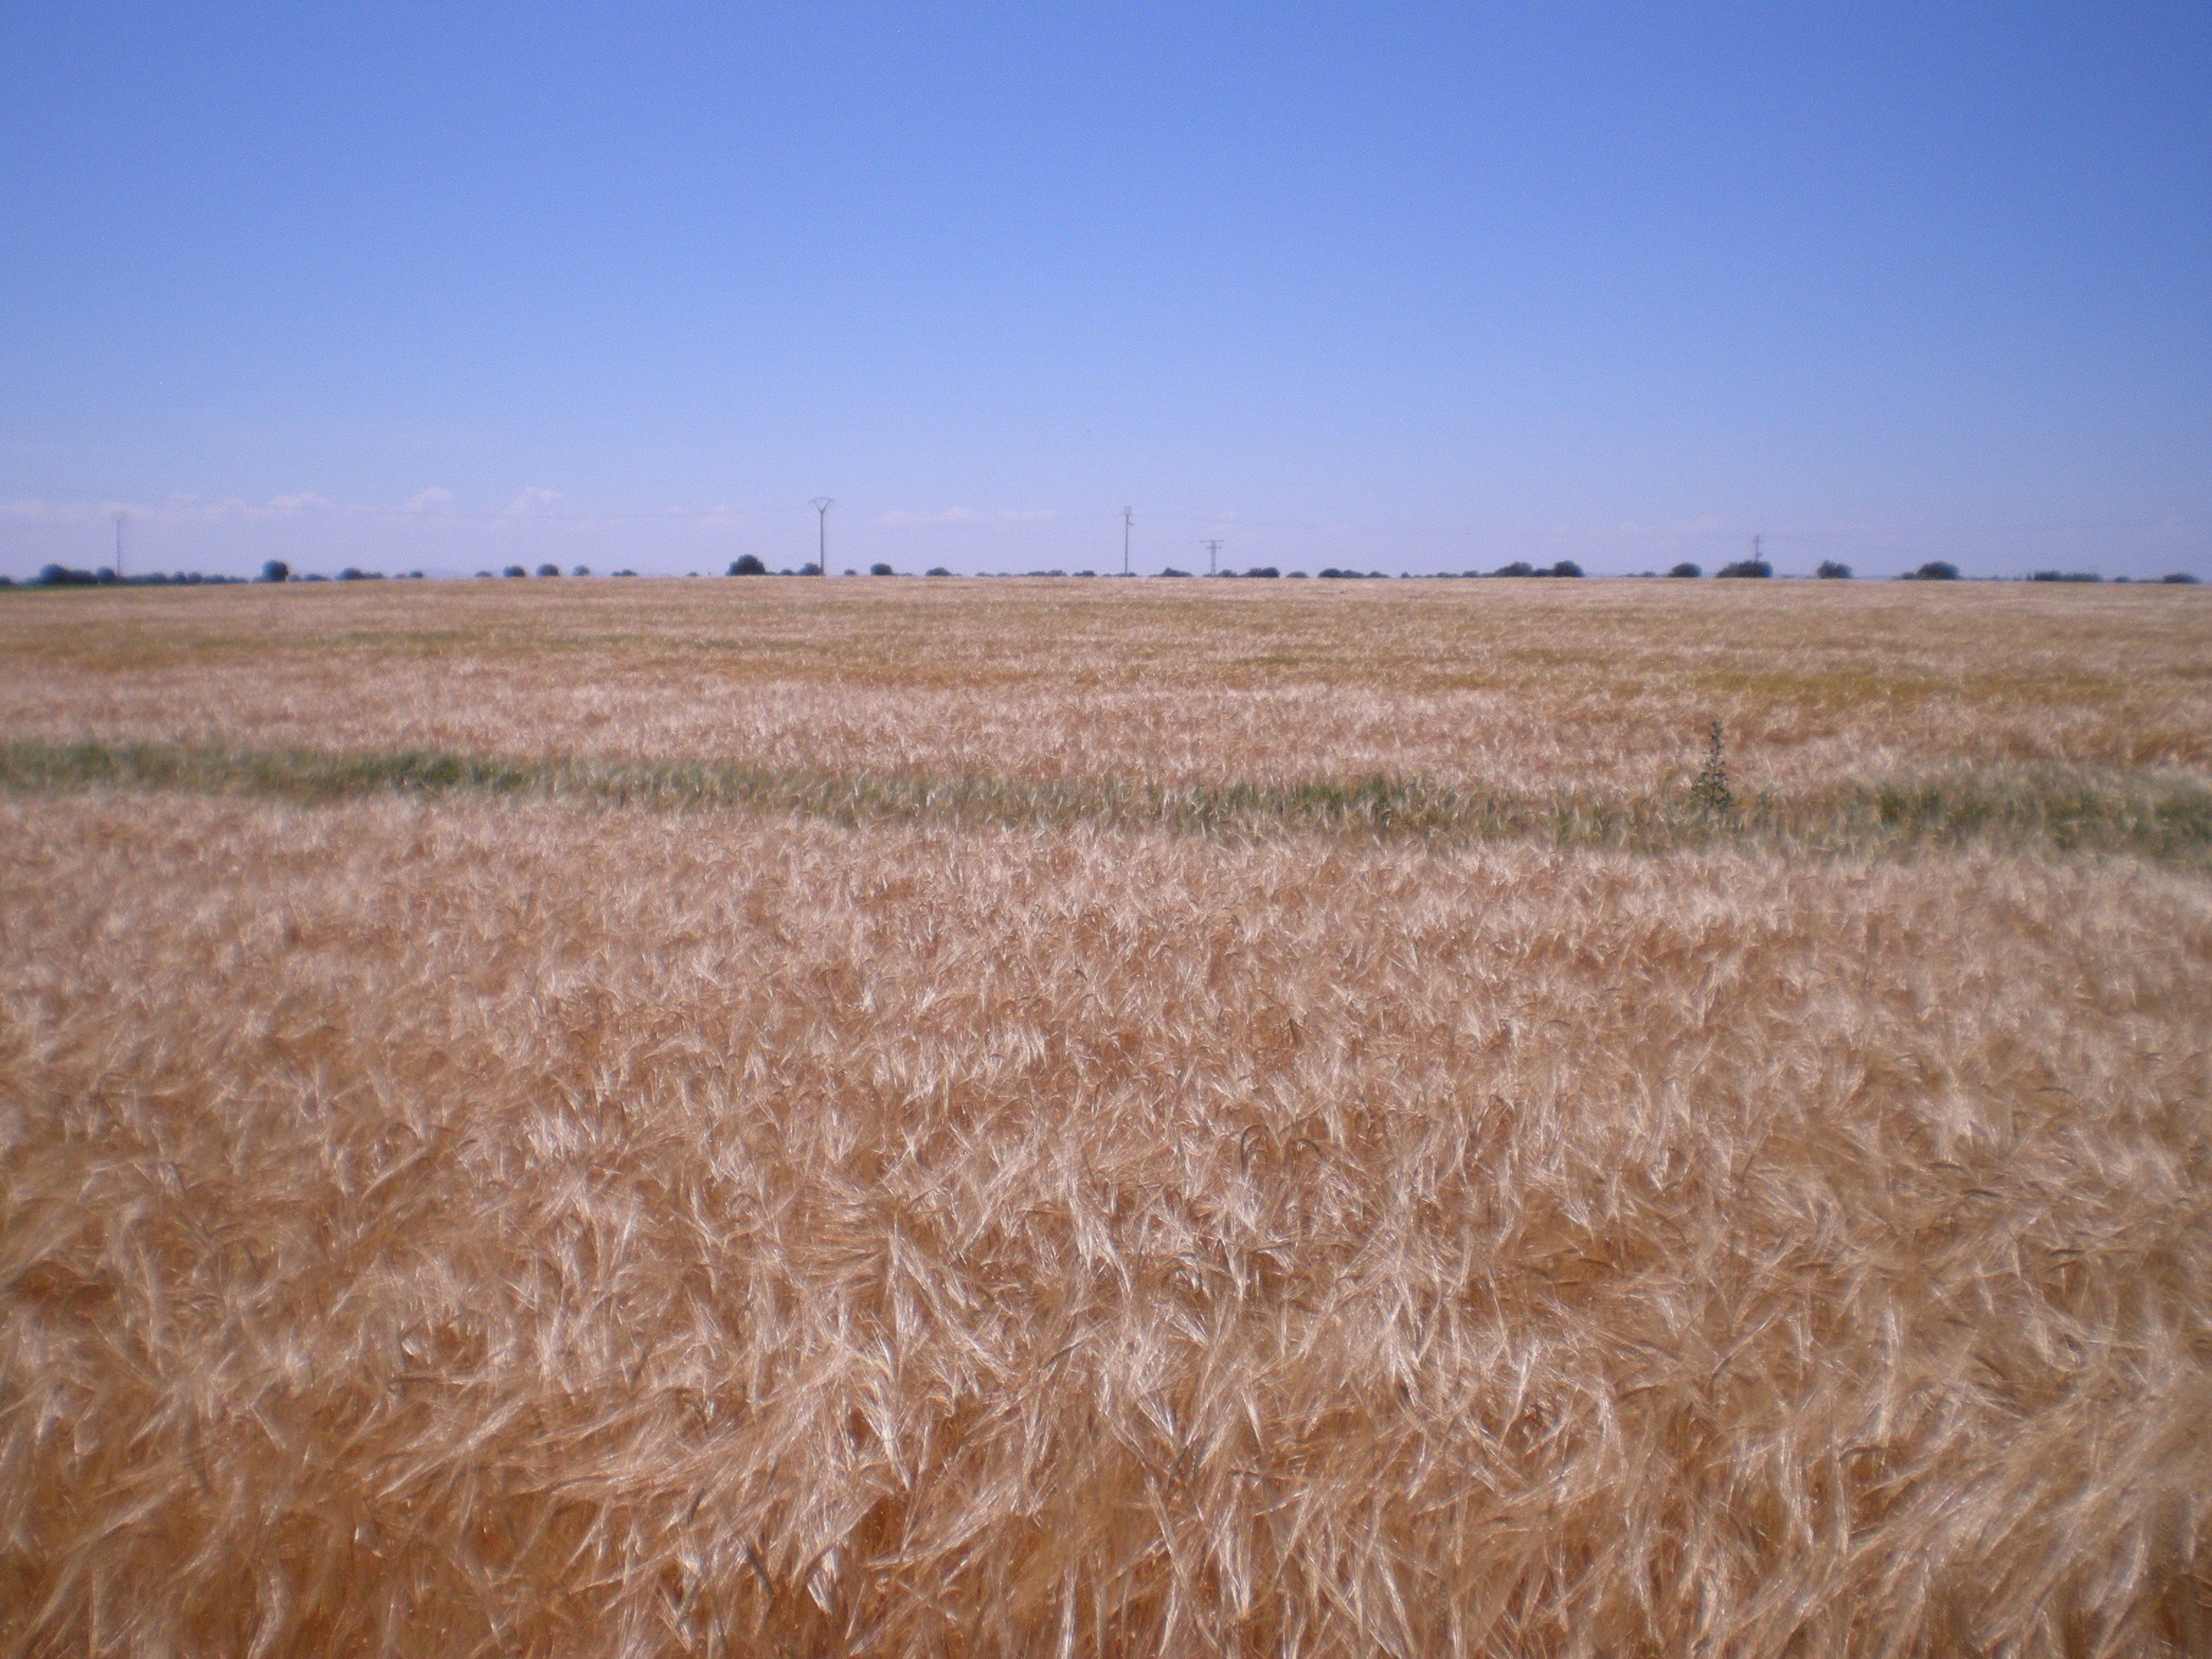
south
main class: Cropland
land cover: Dry pulses
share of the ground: > 75 %
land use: Agriculture (excluding fallow land and kitchen gardens)
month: May
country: ES
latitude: 39.1709
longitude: -3.4556
